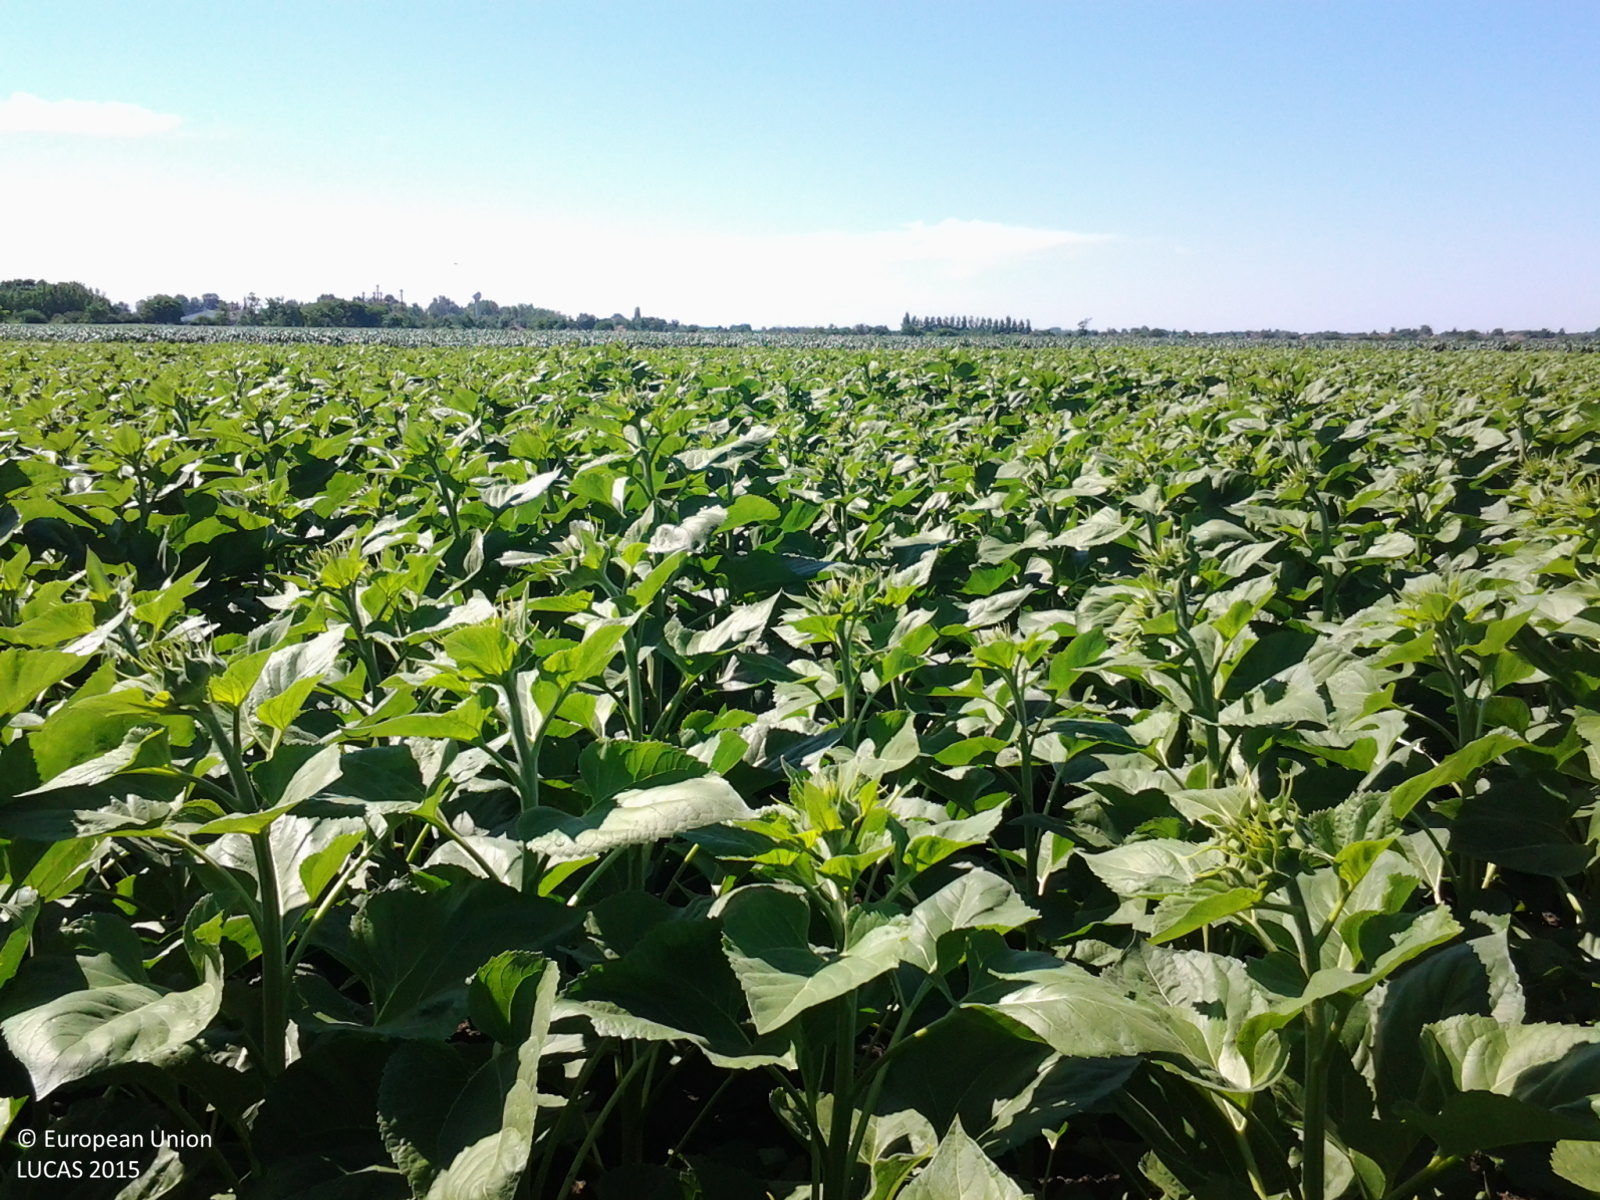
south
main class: Cropland
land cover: Sunflower
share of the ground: > 75 %
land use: Agriculture (excluding fallow land and kitchen gardens)
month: June
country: HU
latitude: 46.5997
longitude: 20.6414
